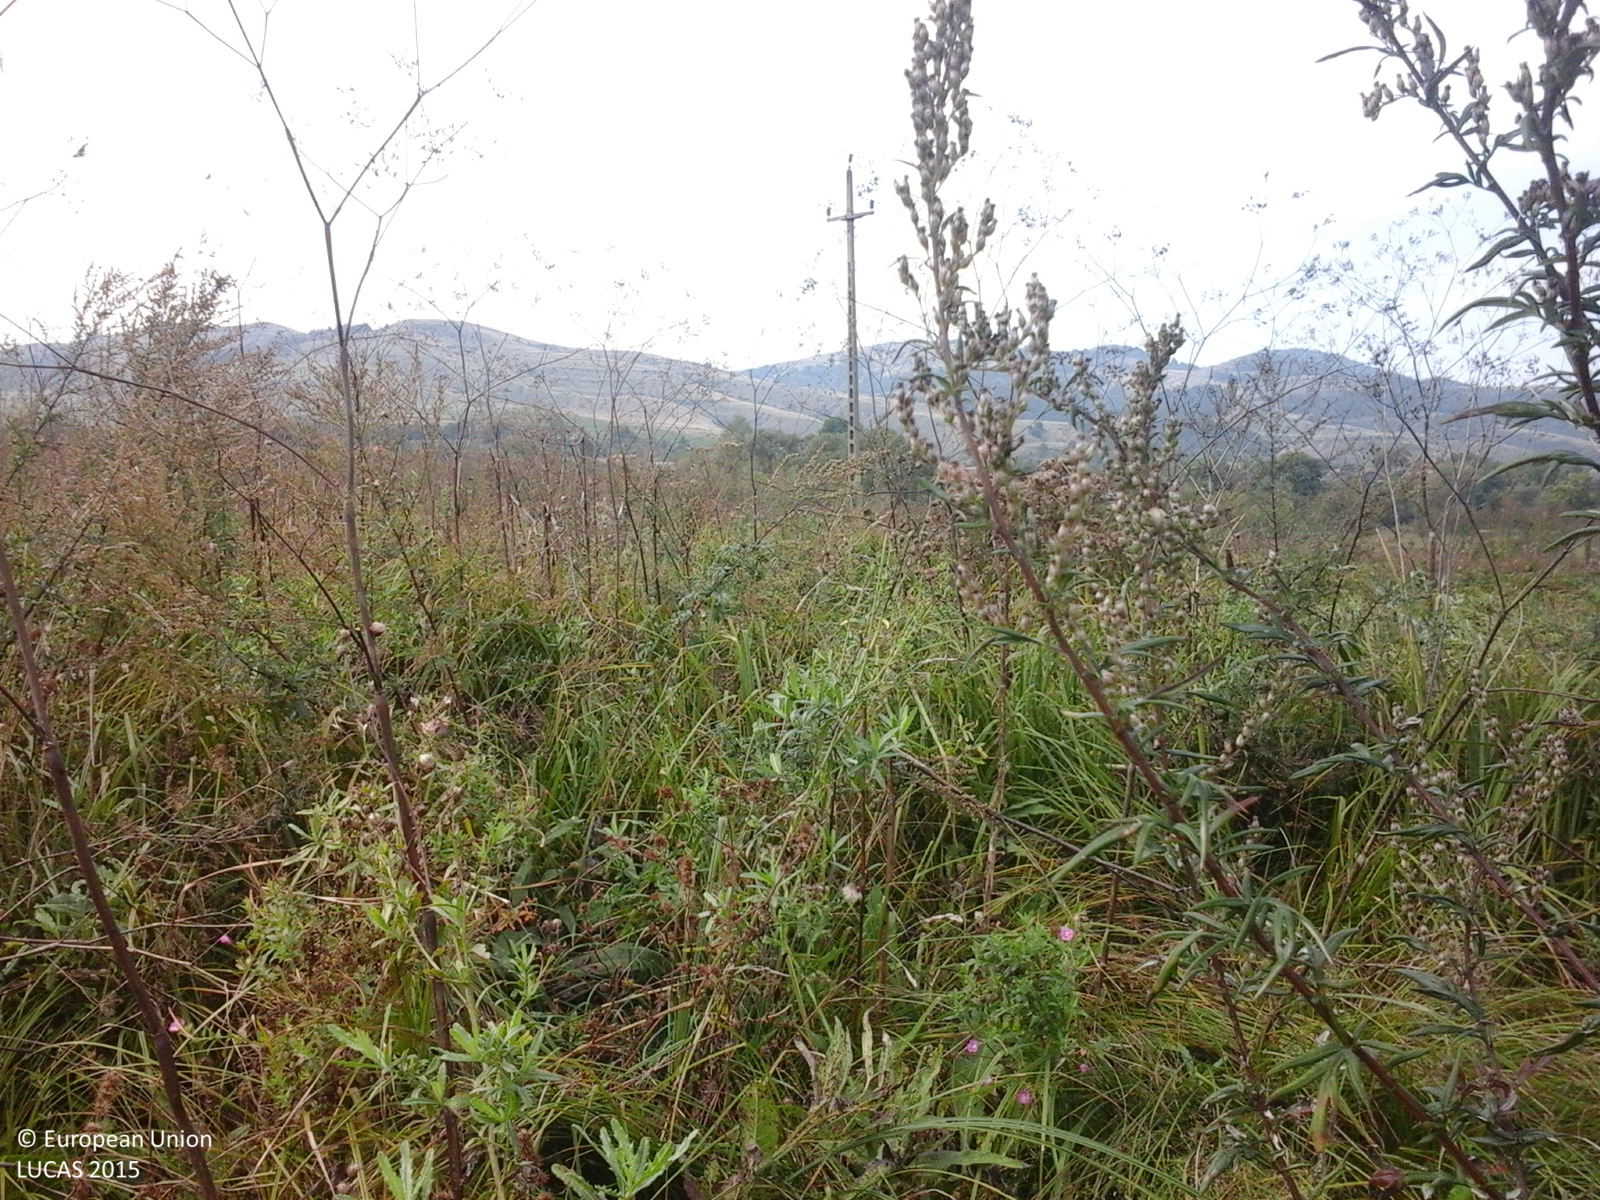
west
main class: Grassland
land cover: Spontaneously vegetated surfaces
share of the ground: > 75 %
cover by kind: herbaceous plants 100 %
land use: Fallow land
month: September
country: RO
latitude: 46.8571
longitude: 22.9273
